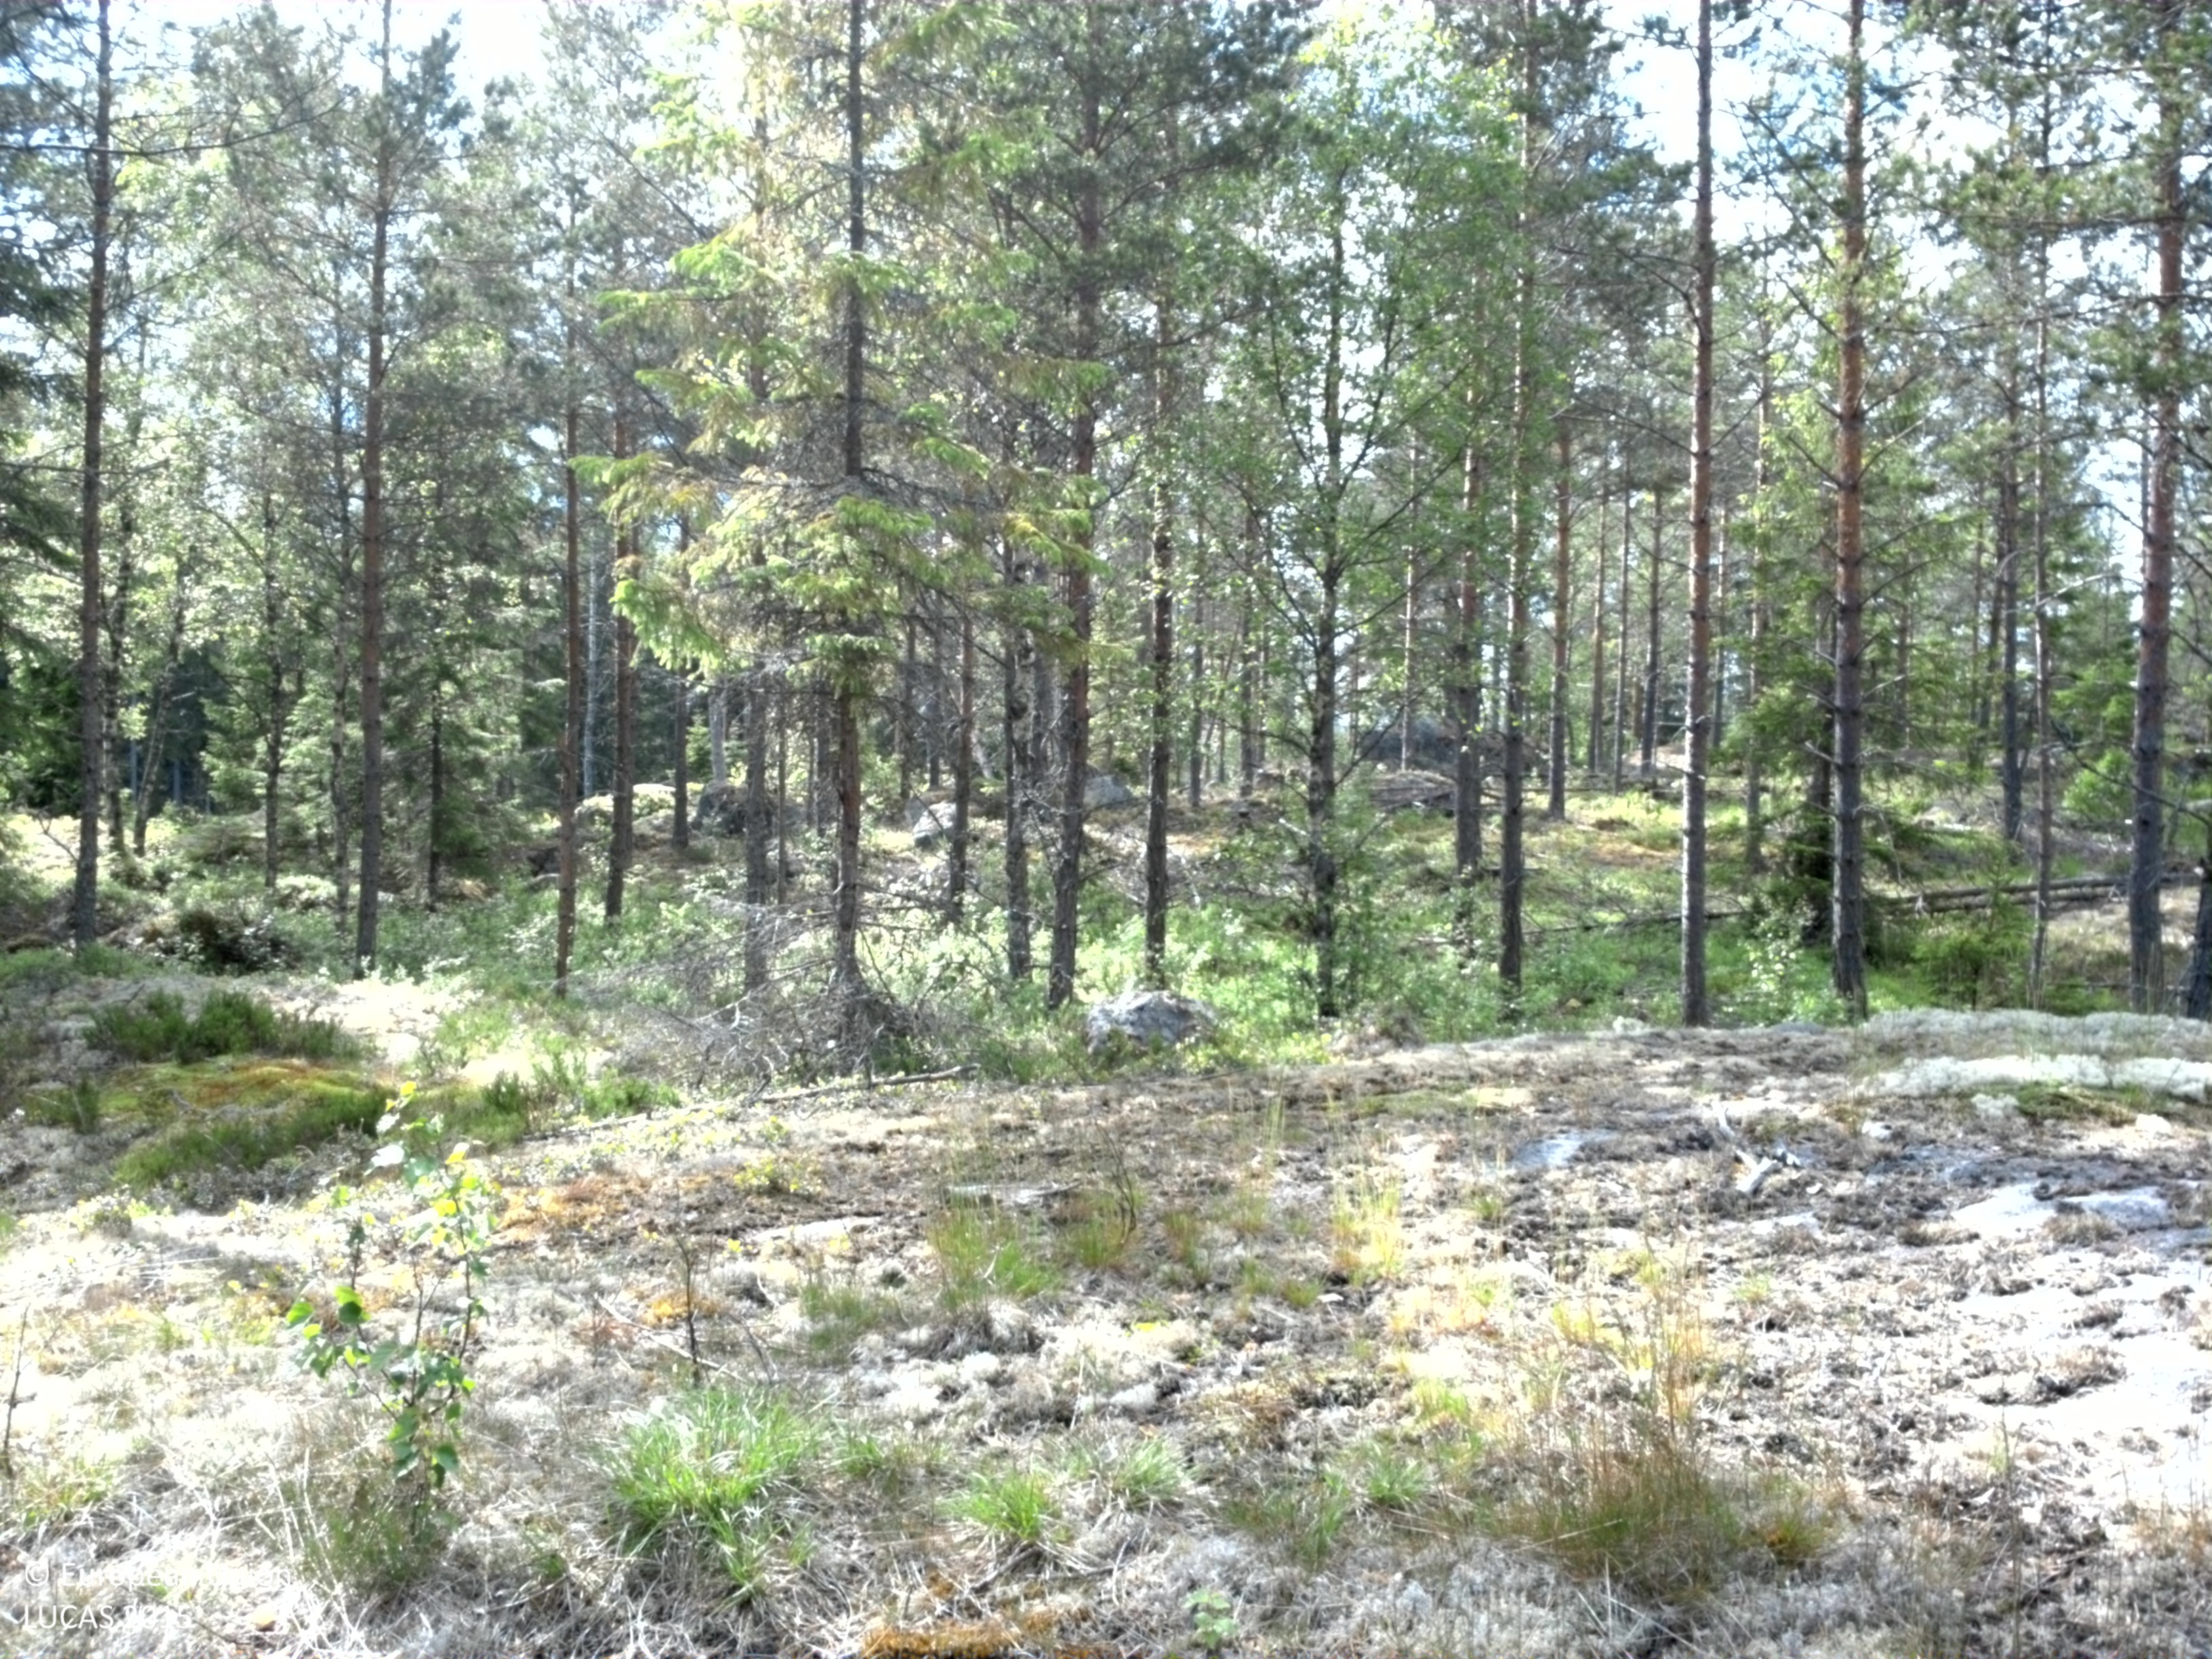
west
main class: Woodland
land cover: Pine dominated coniferous woodland
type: boreal forest
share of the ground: 50 - 75 %
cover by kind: coniferous forest trees 45 %, herbaceous plants 30 %, lichens and mosses 20 %, broadleaved forest trees 5 %
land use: Forestry
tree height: > 5 m
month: June
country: SE
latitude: 59.9619
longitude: 17.1741
